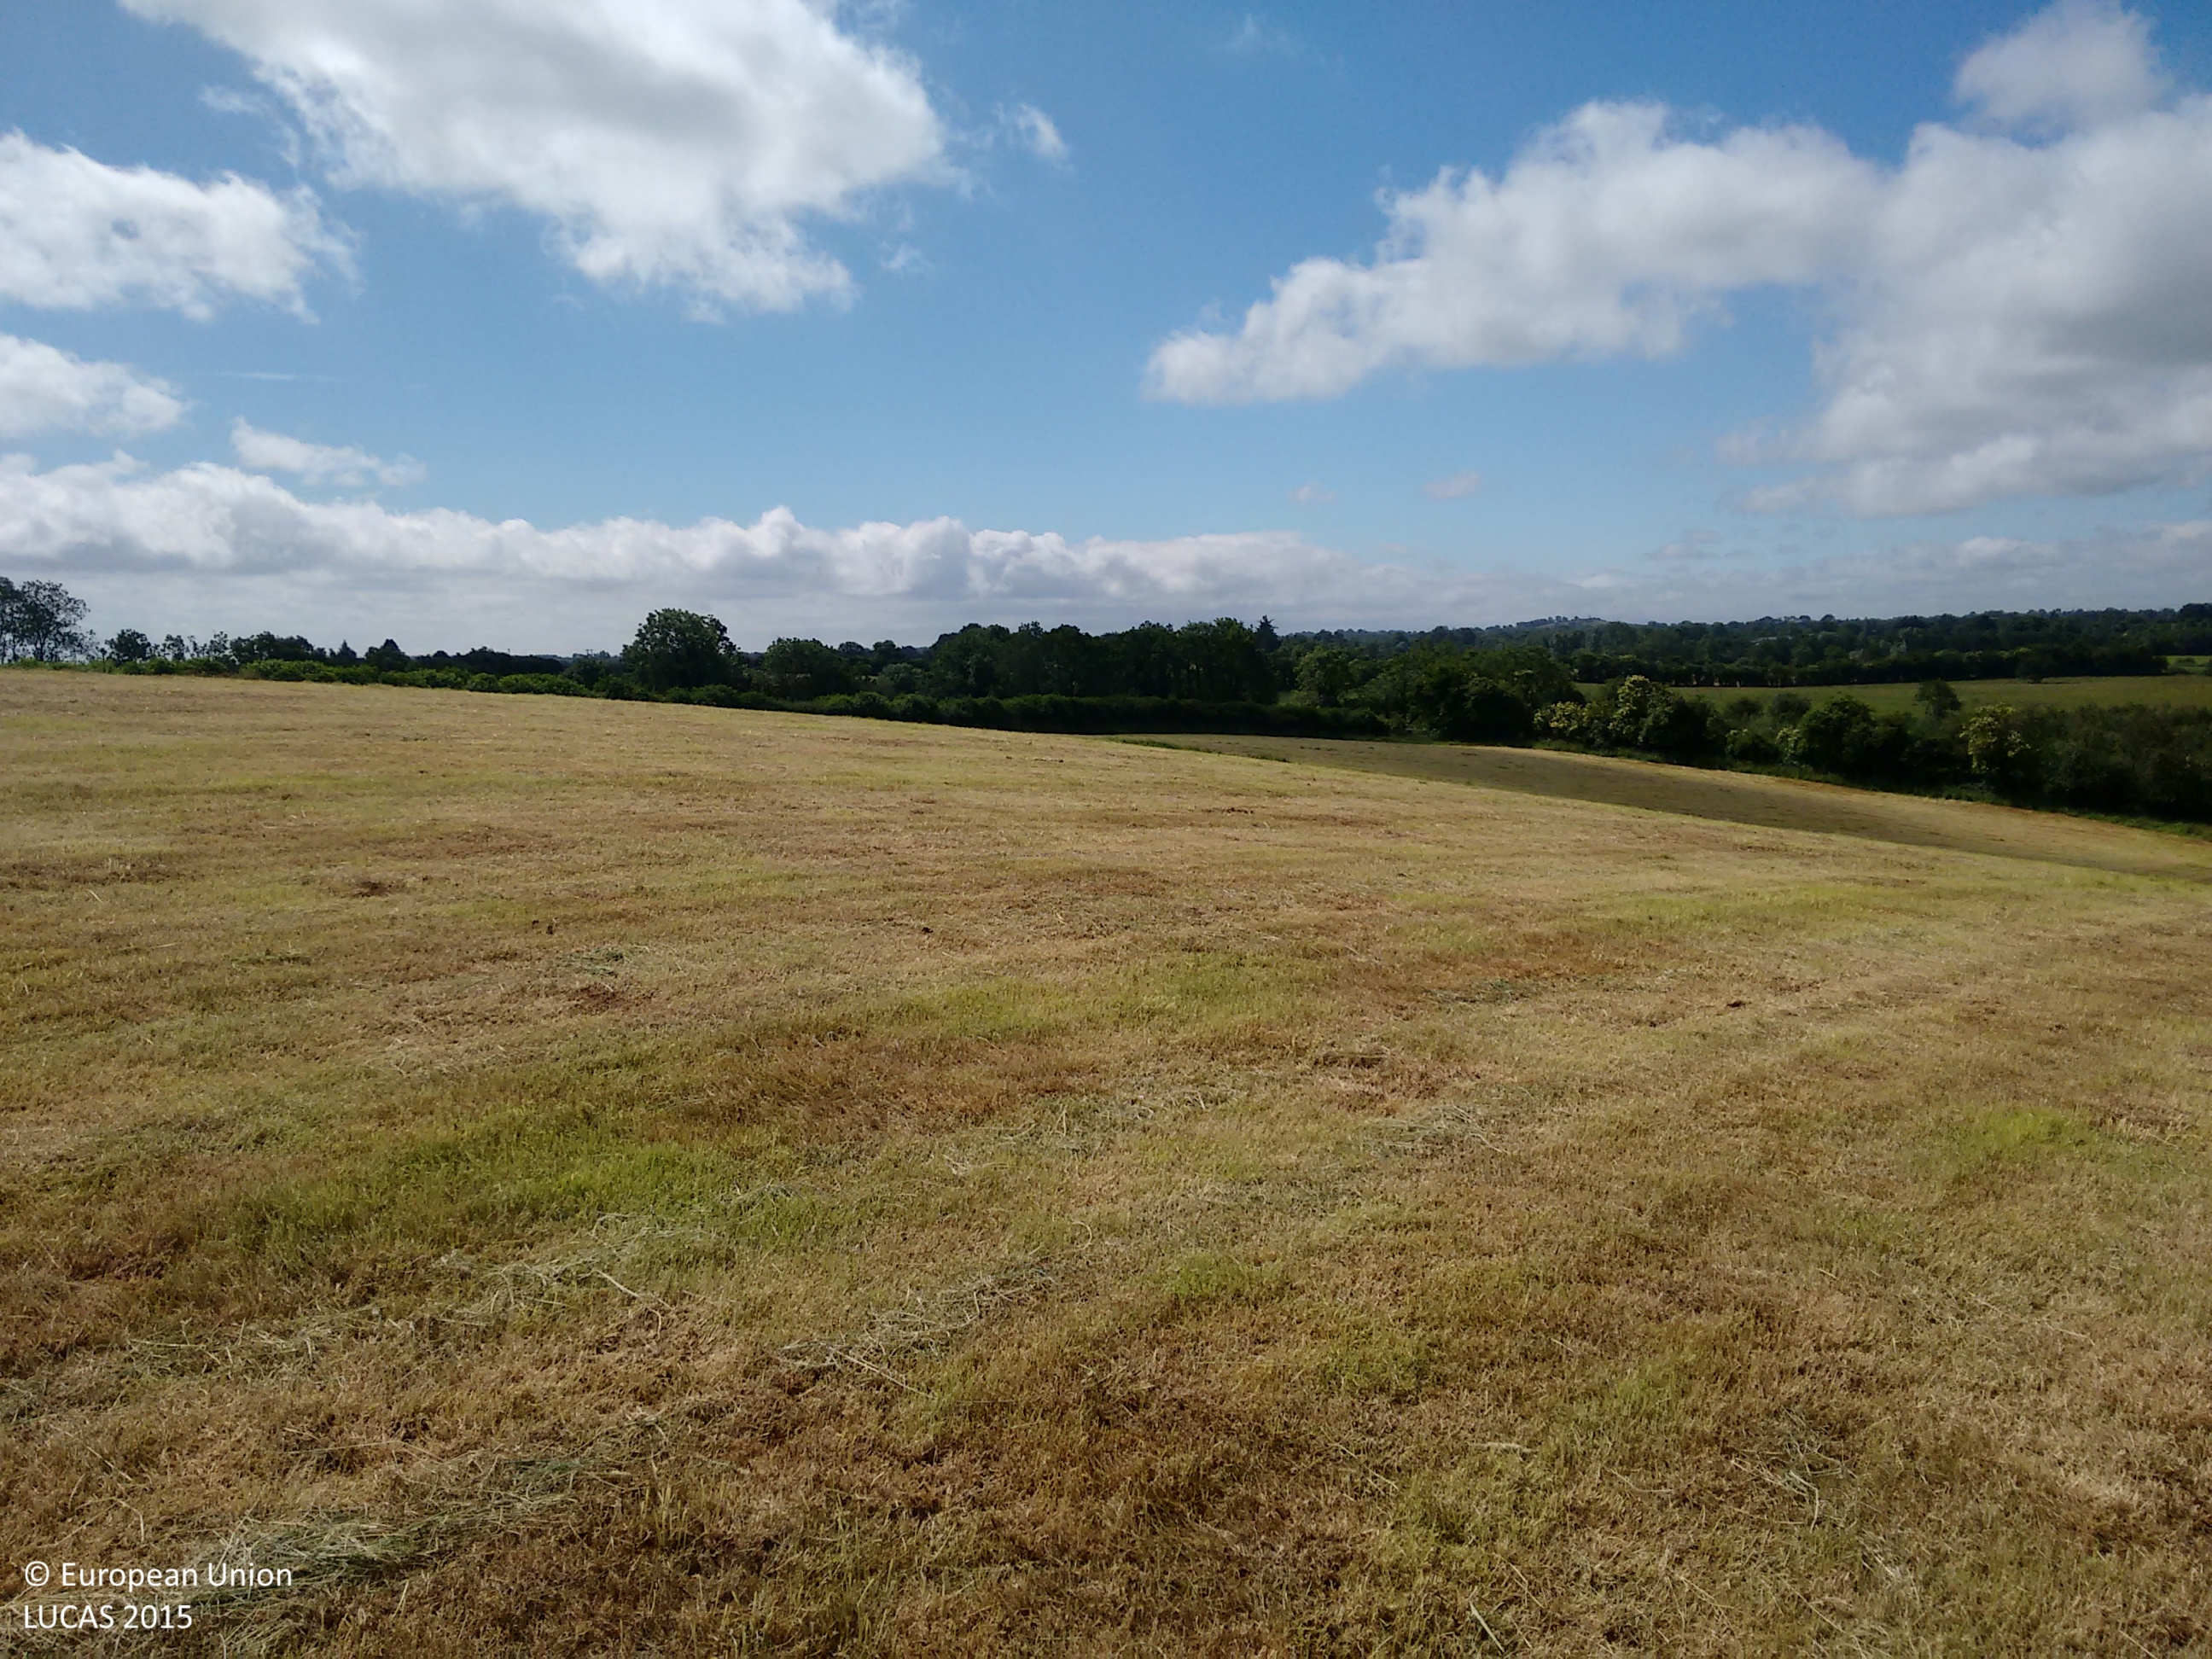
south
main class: Grassland
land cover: Grassland without tree/shrub cover
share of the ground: > 75 %
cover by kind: herbaceous plants 100 %
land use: Agriculture (excluding fallow land and kitchen gardens)
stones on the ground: < 10 %
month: June
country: IE
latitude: 53.7079
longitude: -6.7843
